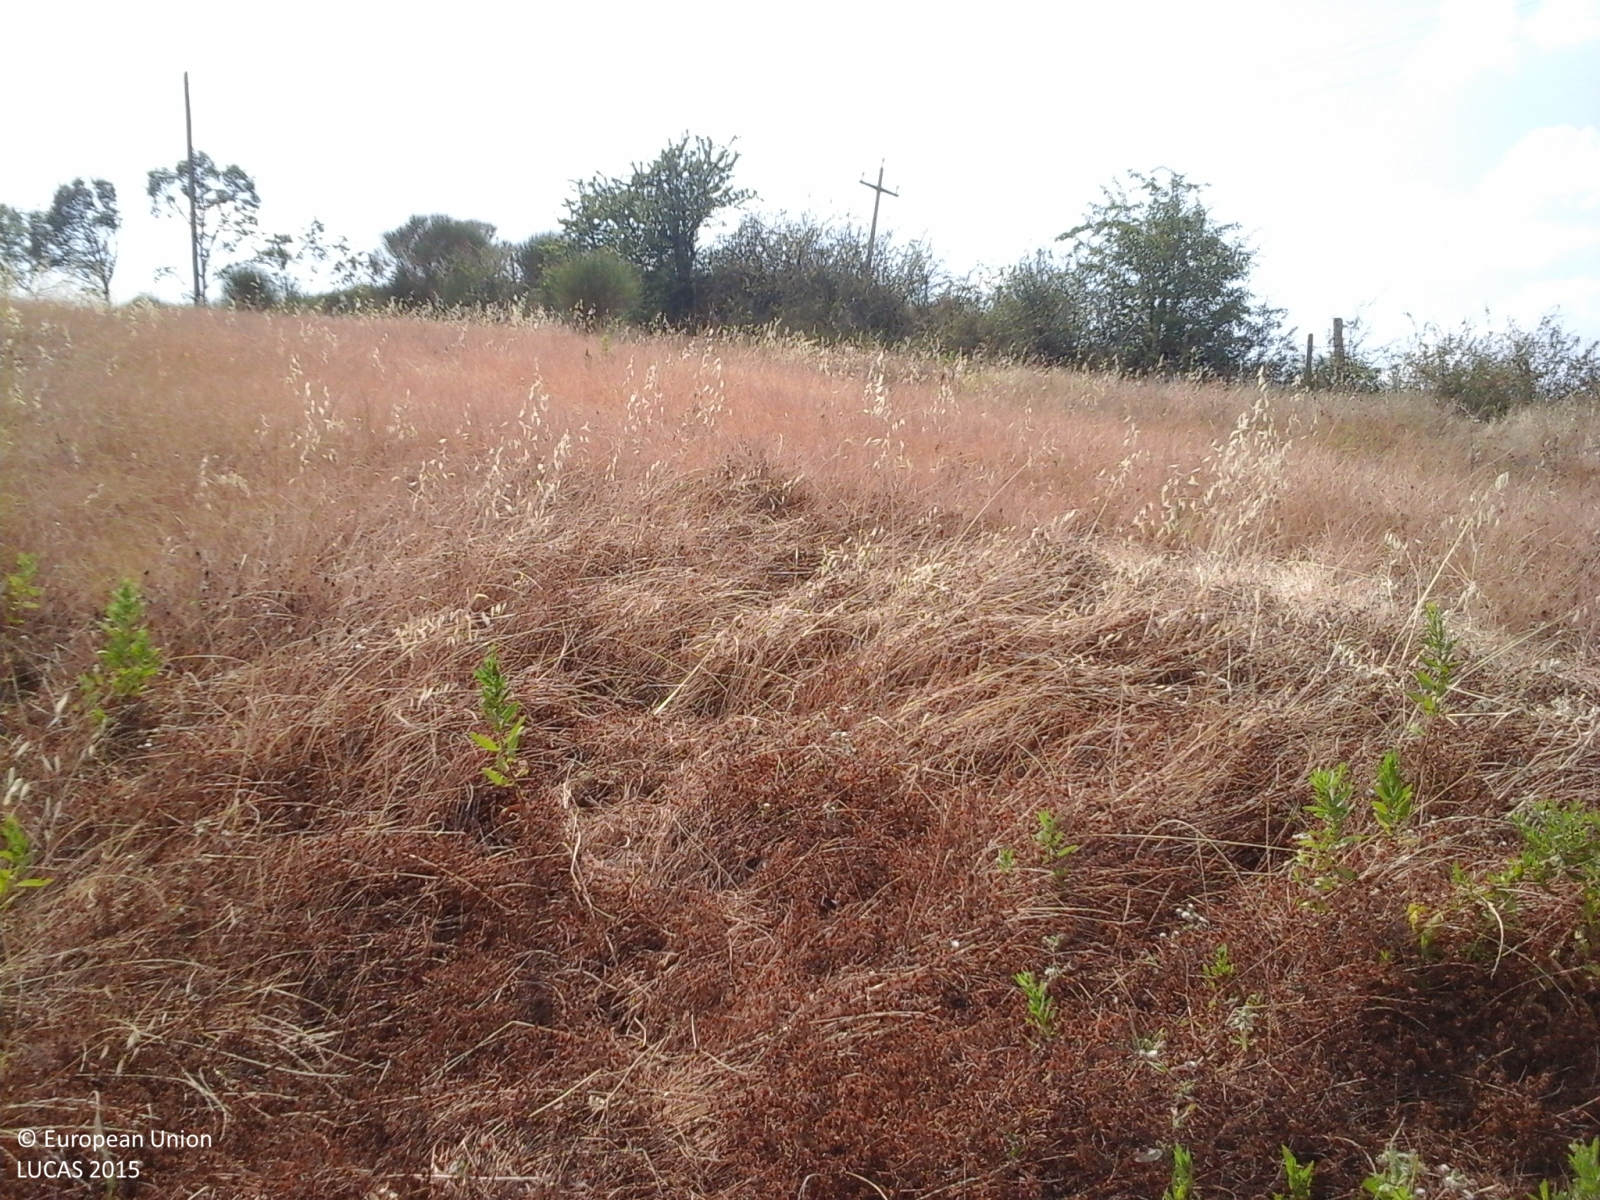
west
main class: Cropland
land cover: Temporary grasslands
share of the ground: > 75 %
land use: Agriculture (excluding fallow land and kitchen gardens)
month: July
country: IT
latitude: 43.1481
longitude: 11.5325
